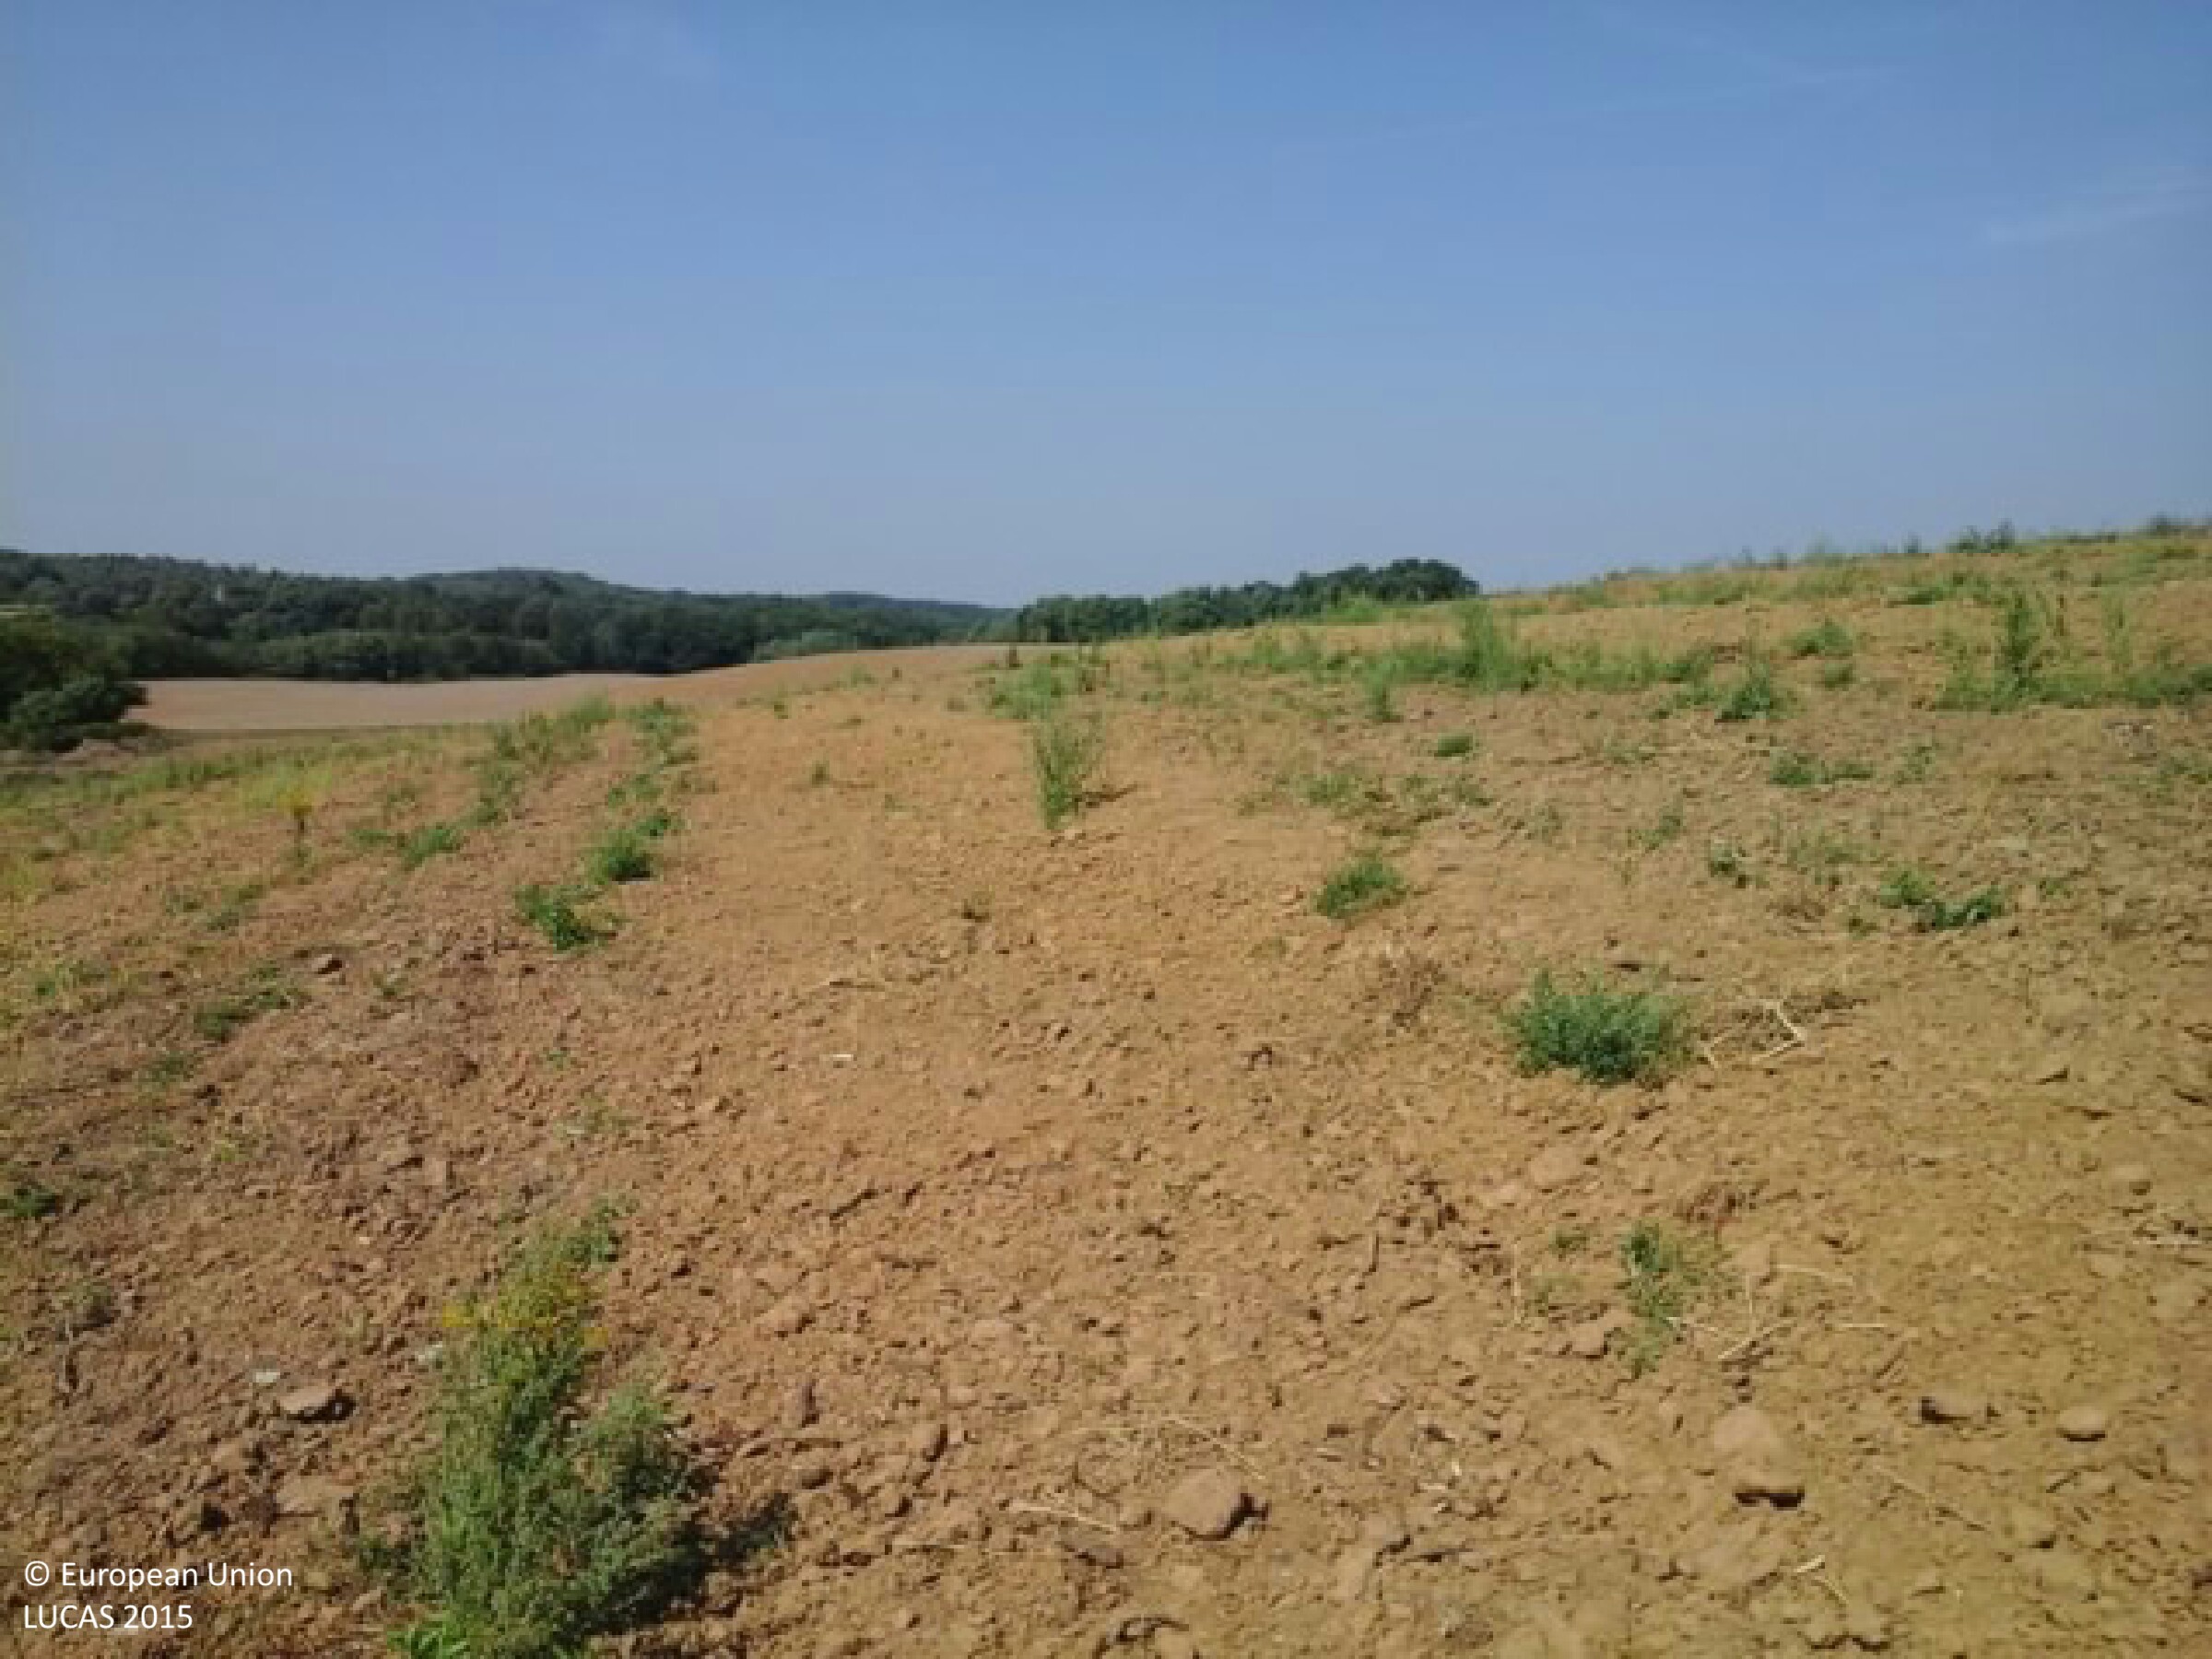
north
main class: Grassland
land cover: Spontaneously vegetated surfaces
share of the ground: 10 - 25 %
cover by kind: unconsolidated bare surface 90 %, herbaceous plants 10 %
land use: Fallow land
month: May
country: HU
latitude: 46.3119
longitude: 17.6535
